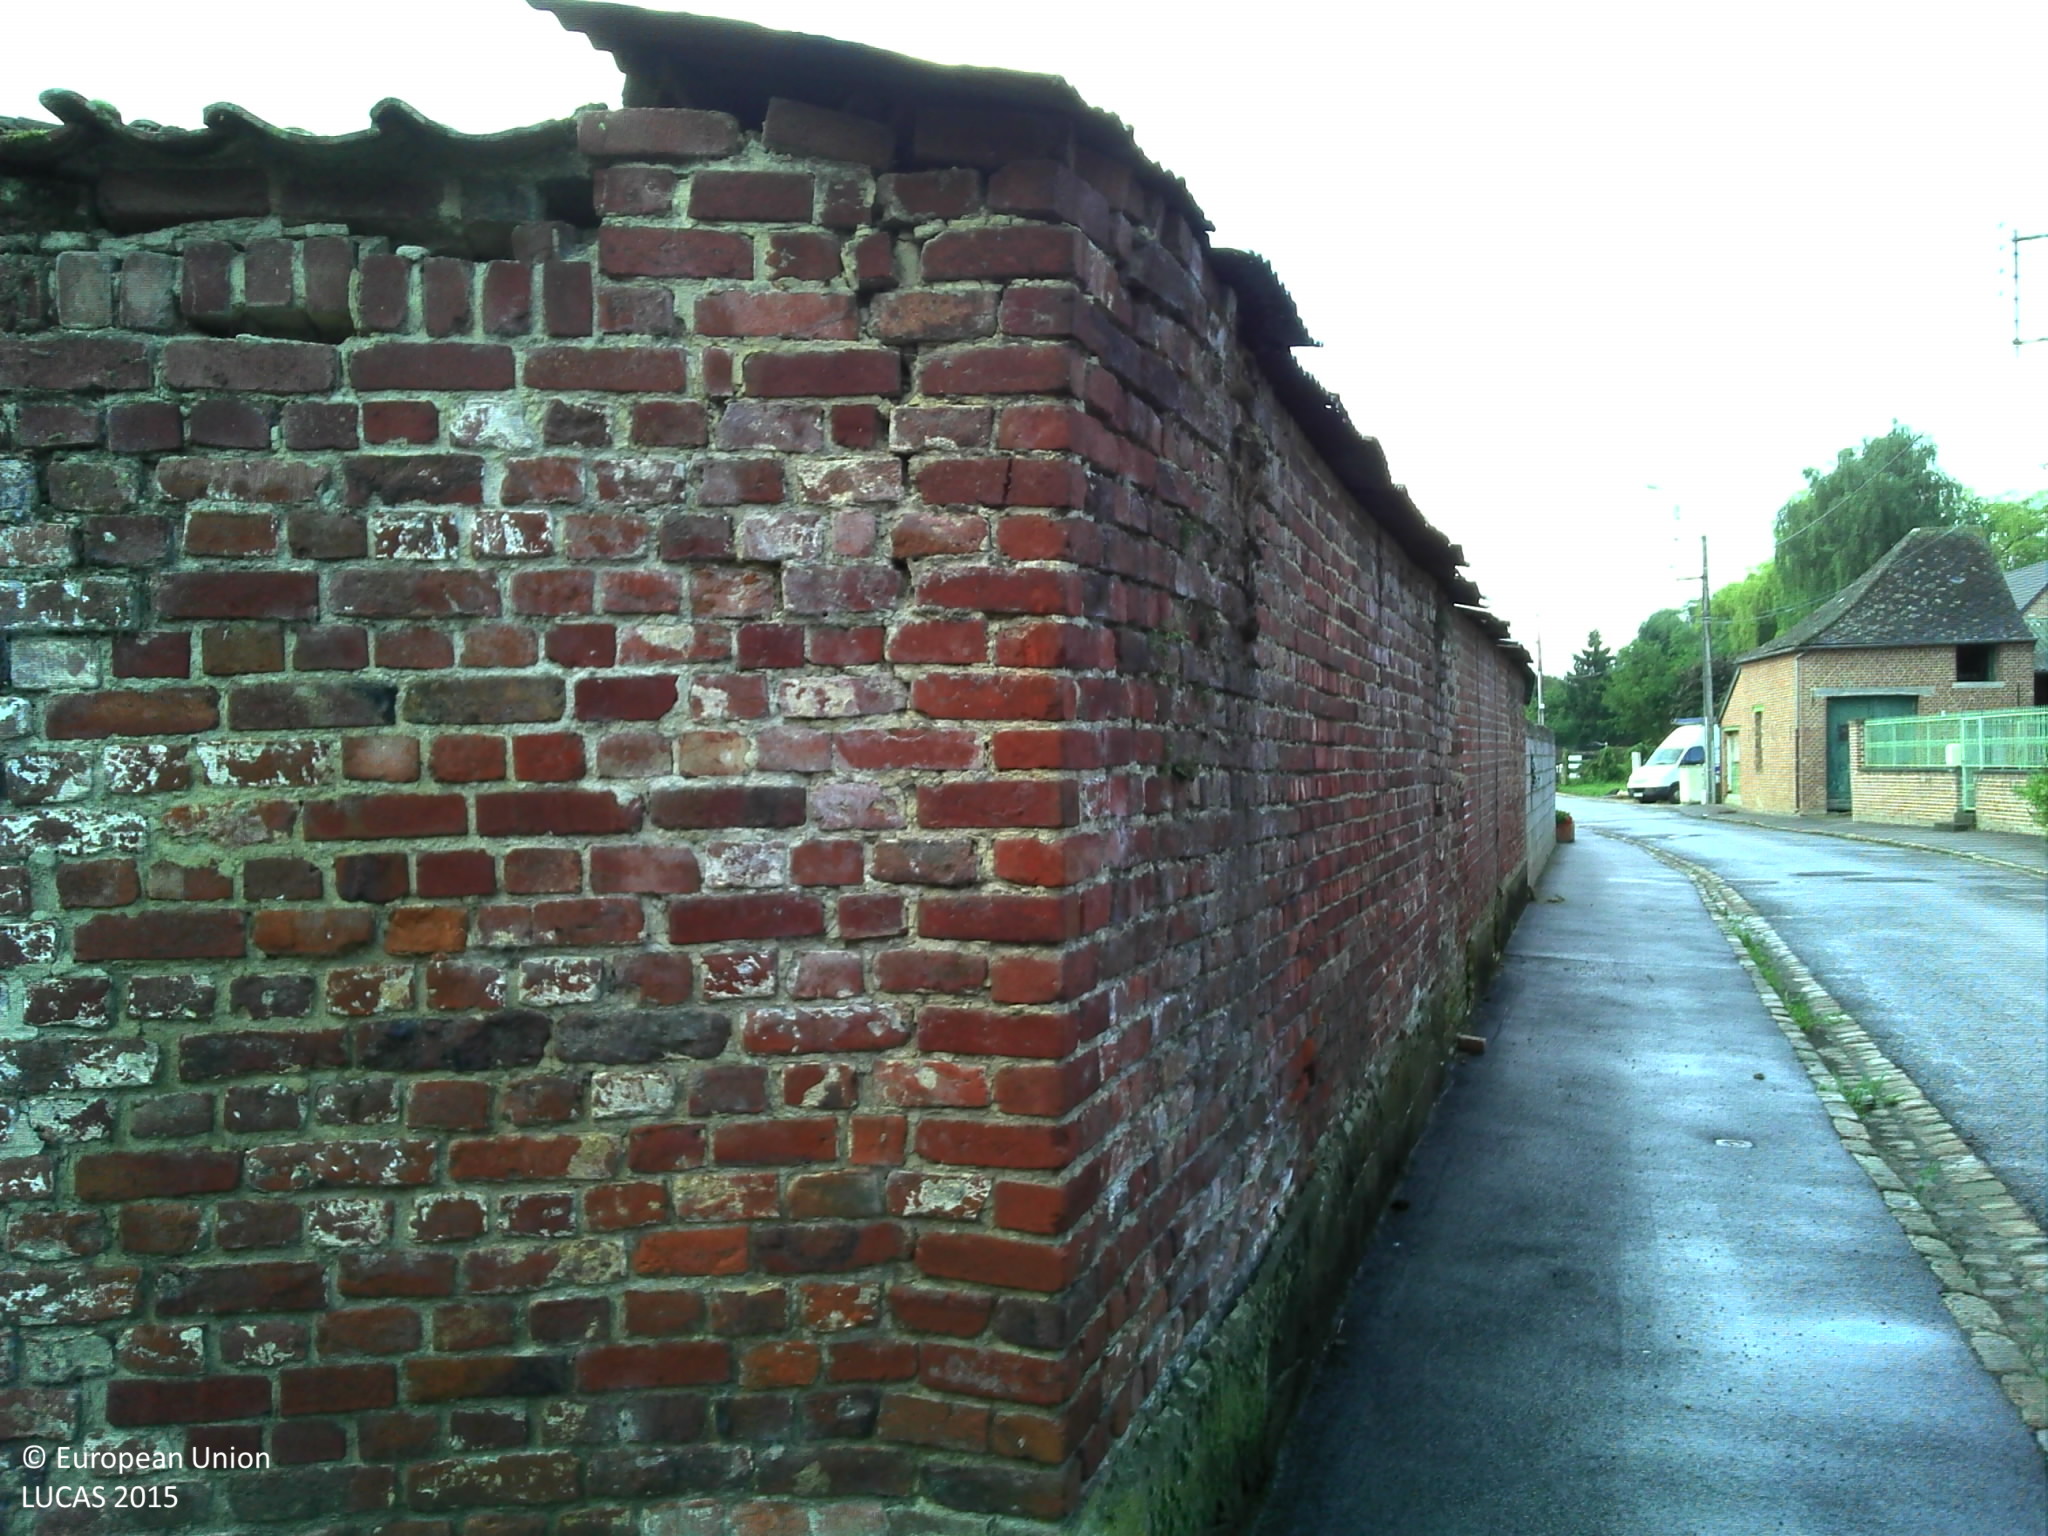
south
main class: Woodland
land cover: Broadleaved woodland
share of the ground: > 75 %
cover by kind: broadleaved forest trees 85 %, herbaceous plants 15 %
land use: Residential
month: July
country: FR
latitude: 50.3292
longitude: 3.6011
